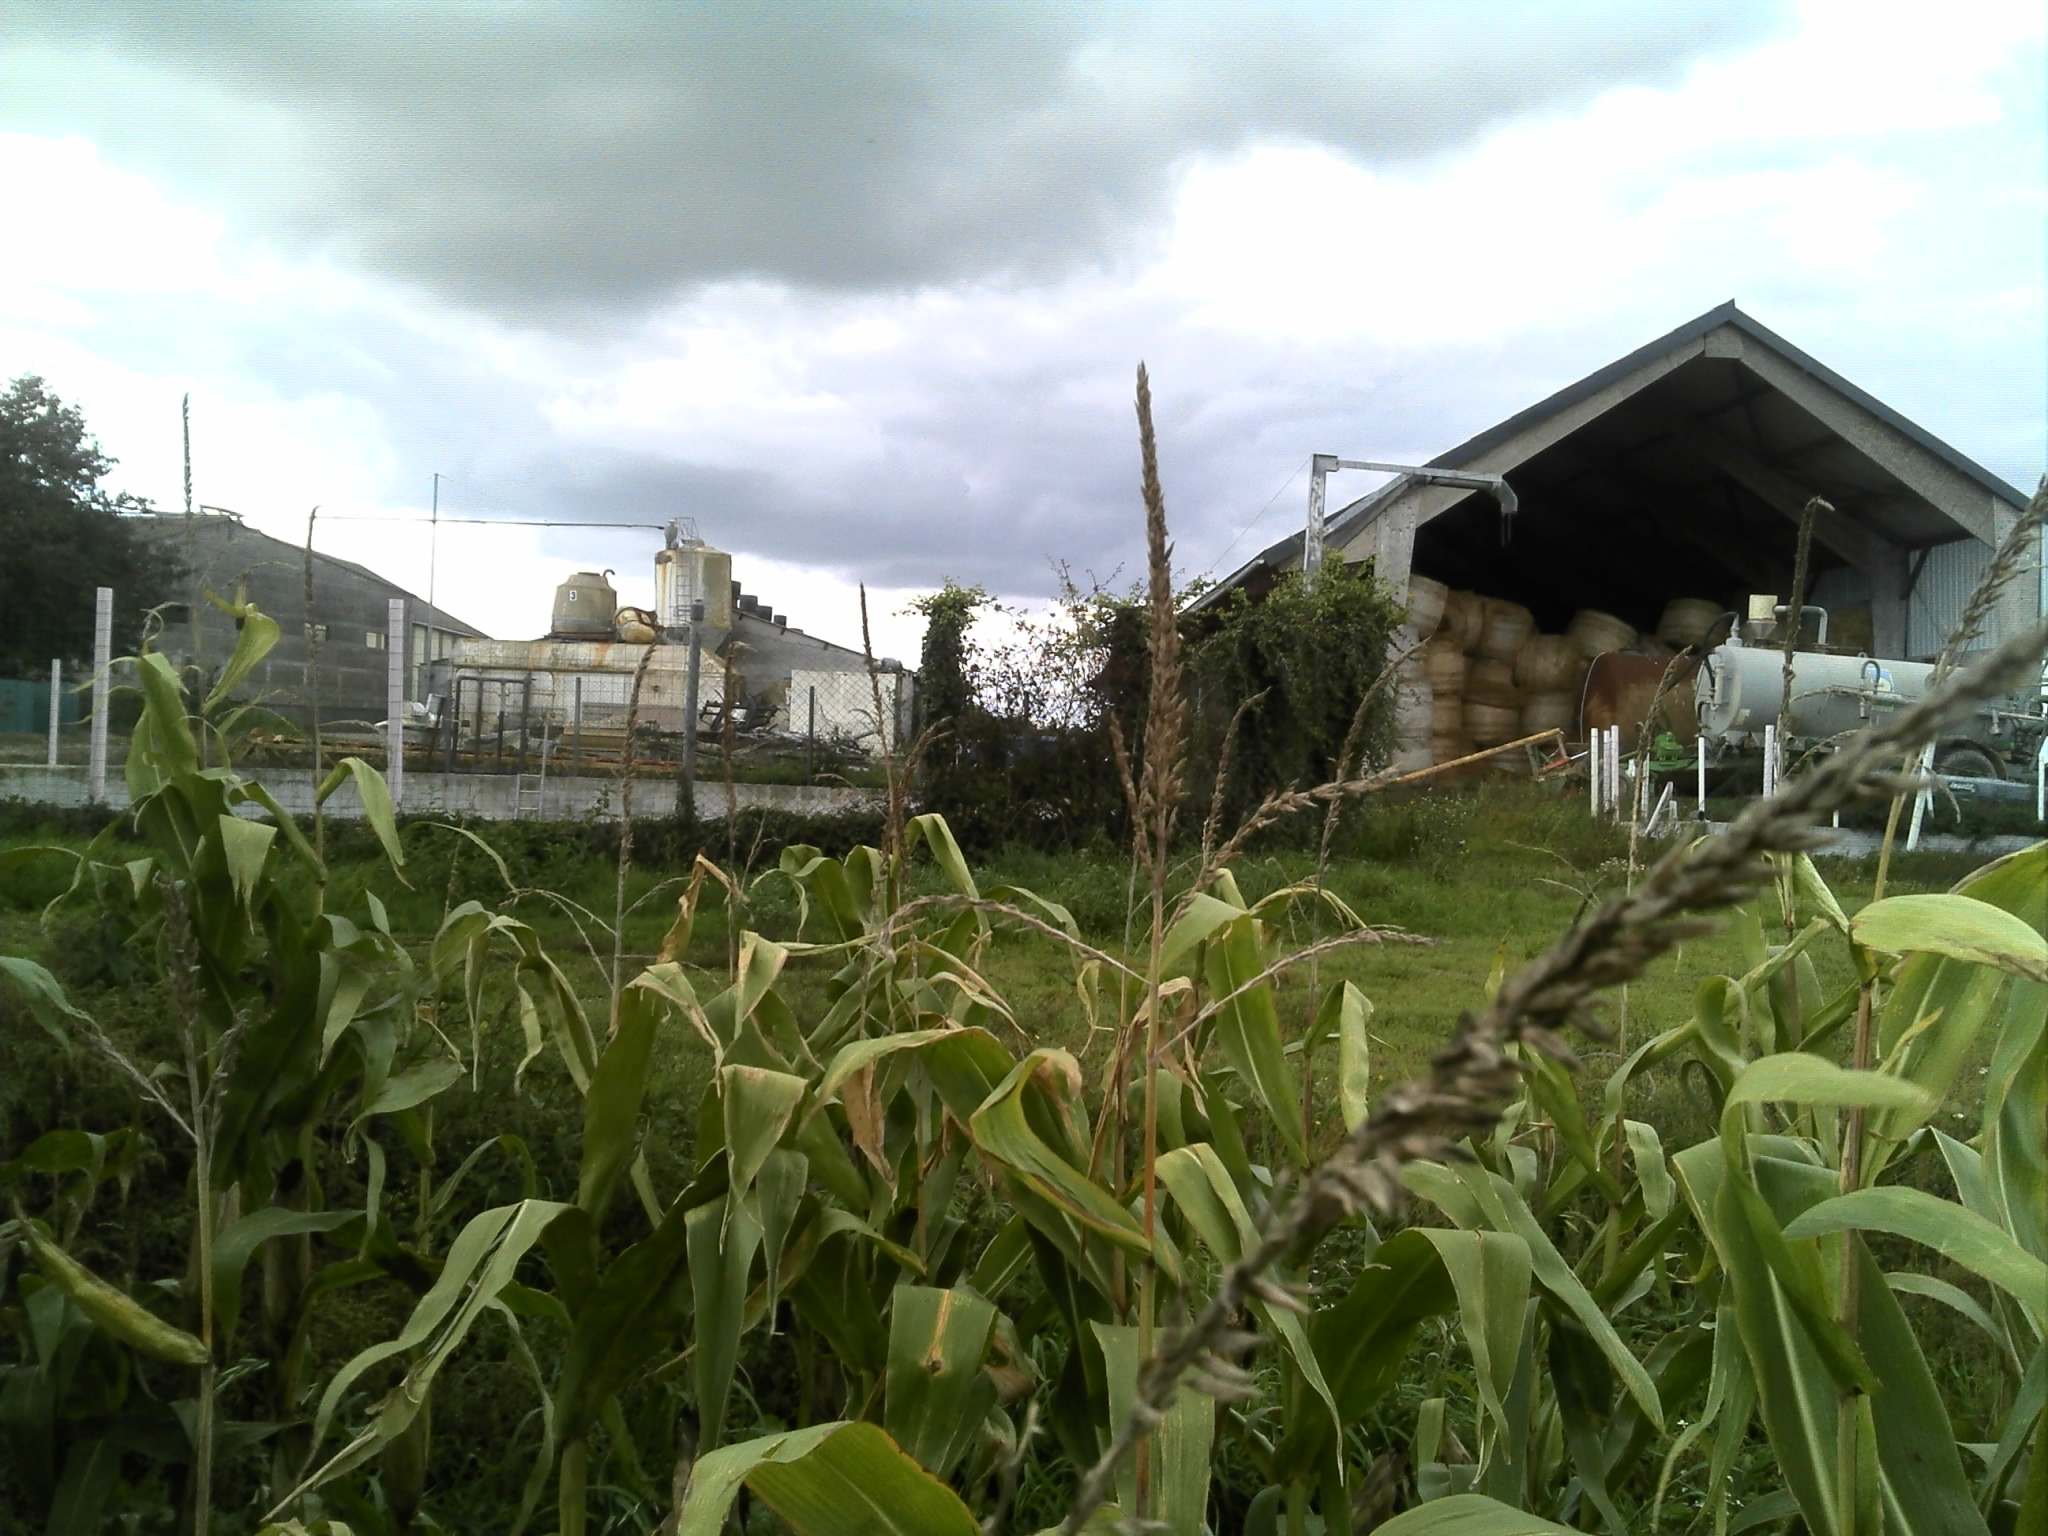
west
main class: Cropland
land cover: Maize
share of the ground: > 75 %
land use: Agriculture (excluding fallow land and kitchen gardens)
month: October
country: FR
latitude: 47.7673
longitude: -1.1273
